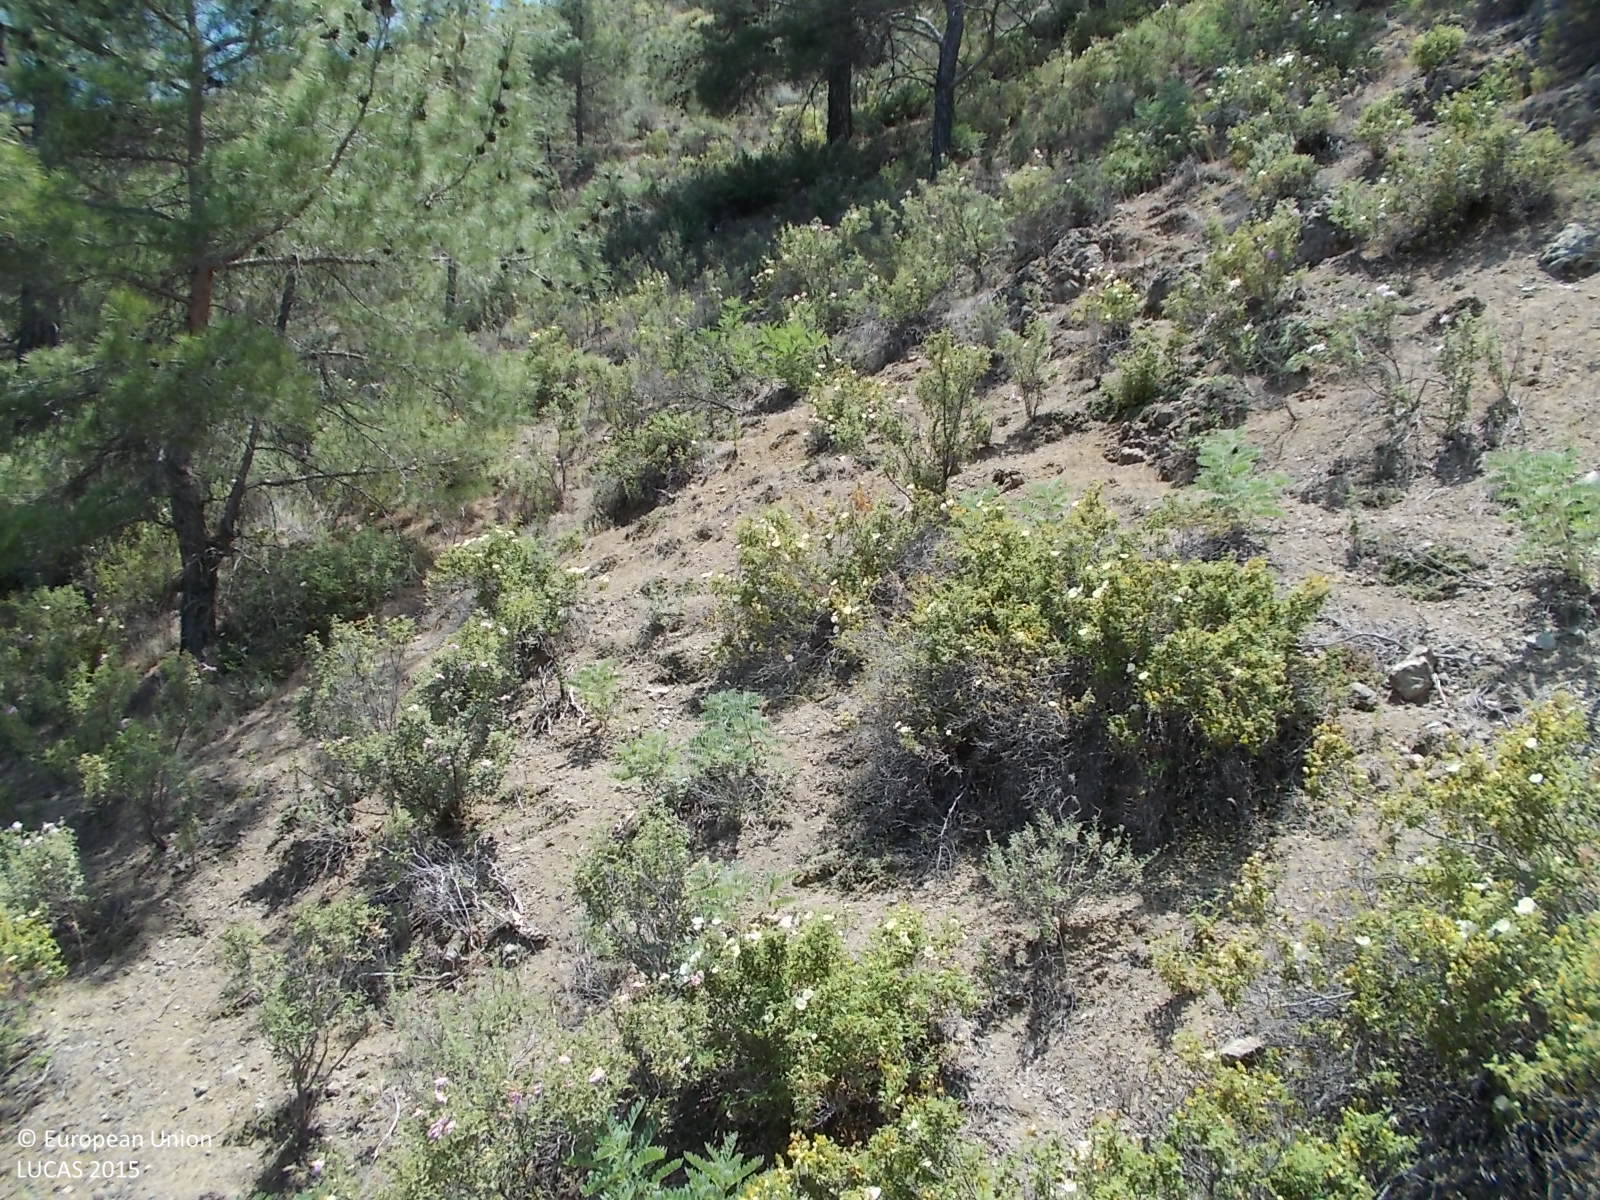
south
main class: Woodland
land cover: Pine dominated coniferous woodland
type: coniferous forest of the mediterranean region
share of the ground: 25 - 50 %
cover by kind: coniferous forest trees 40 %, shrubs 40 %, unconsolidated bare surface 20 %
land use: Semi-natural and natural areas not in use
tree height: > 5 m
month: May
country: CY
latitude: 34.8409
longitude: 33.0364
